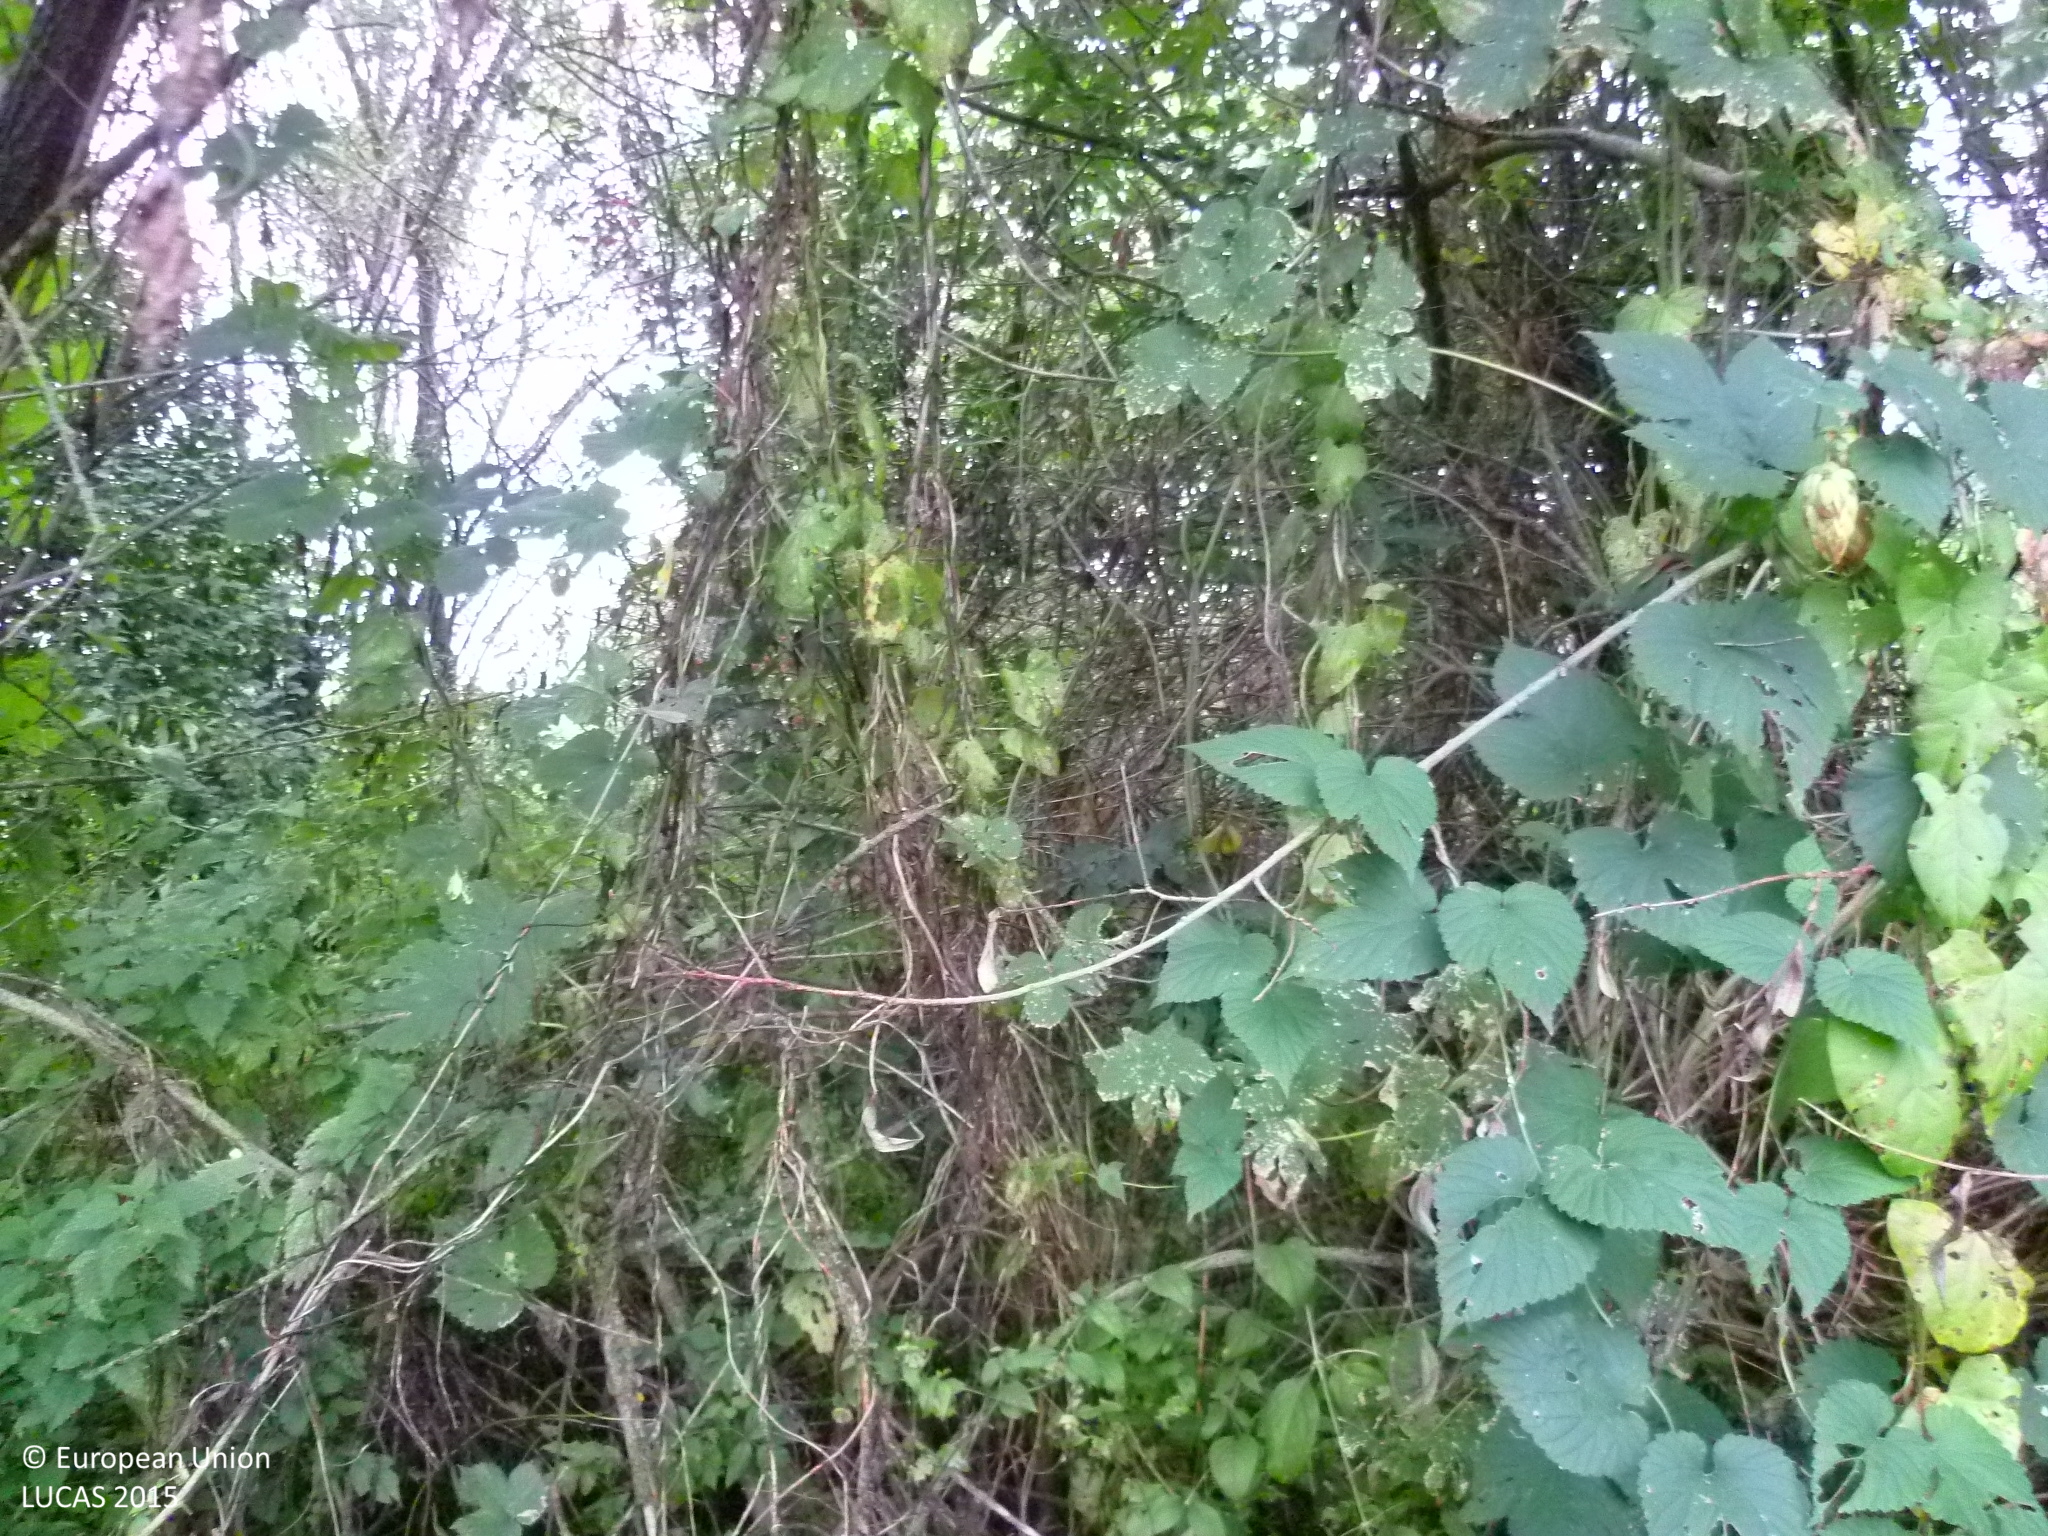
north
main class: Shrubland
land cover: Shrubland with sparse tree cover
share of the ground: > 75 %
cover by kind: shrubs 80 %, herbaceous plants 15 %, broadleaved forest trees 5 %
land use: Semi-natural and natural areas not in use
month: September
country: BG
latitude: 42.5625
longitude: 22.7047
